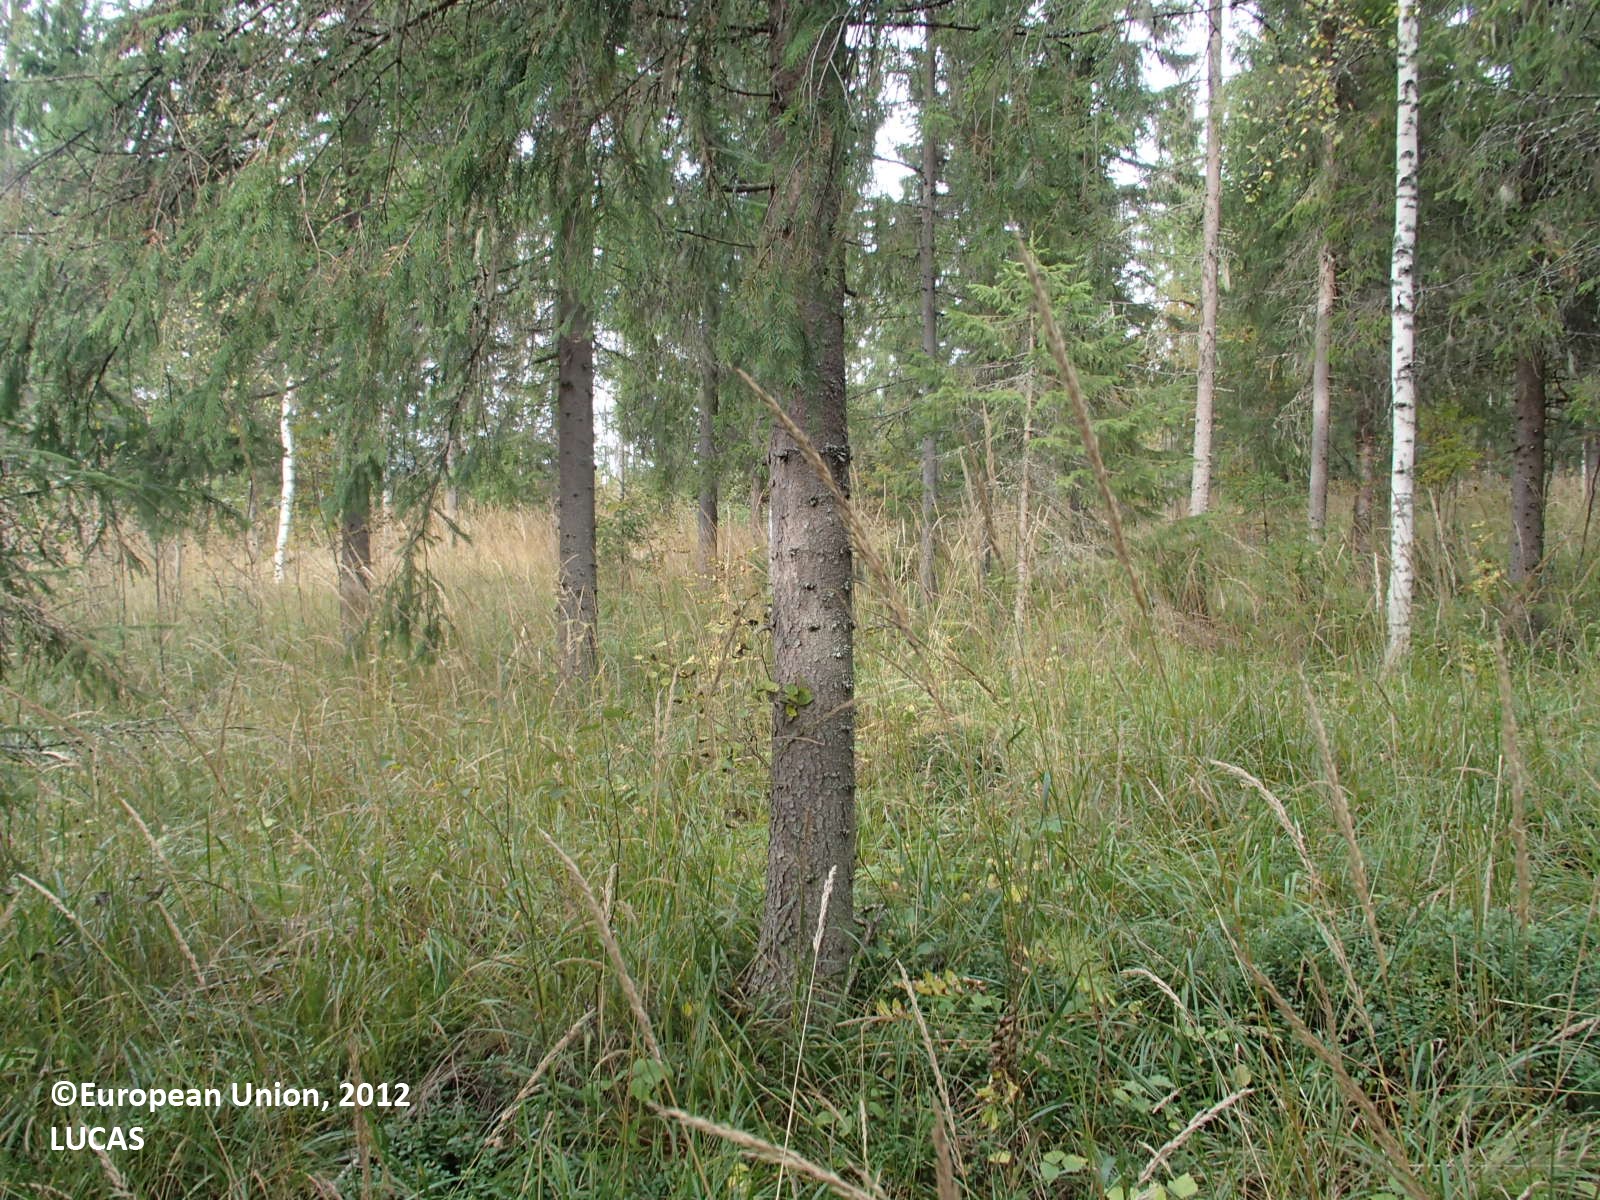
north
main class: Woodland
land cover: Spruce dominated coniferous woodland
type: boreal forest
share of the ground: 50 - 75 %
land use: Forestry
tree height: > 5 m
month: September
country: FI
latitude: 63.3594
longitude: 26.9935
